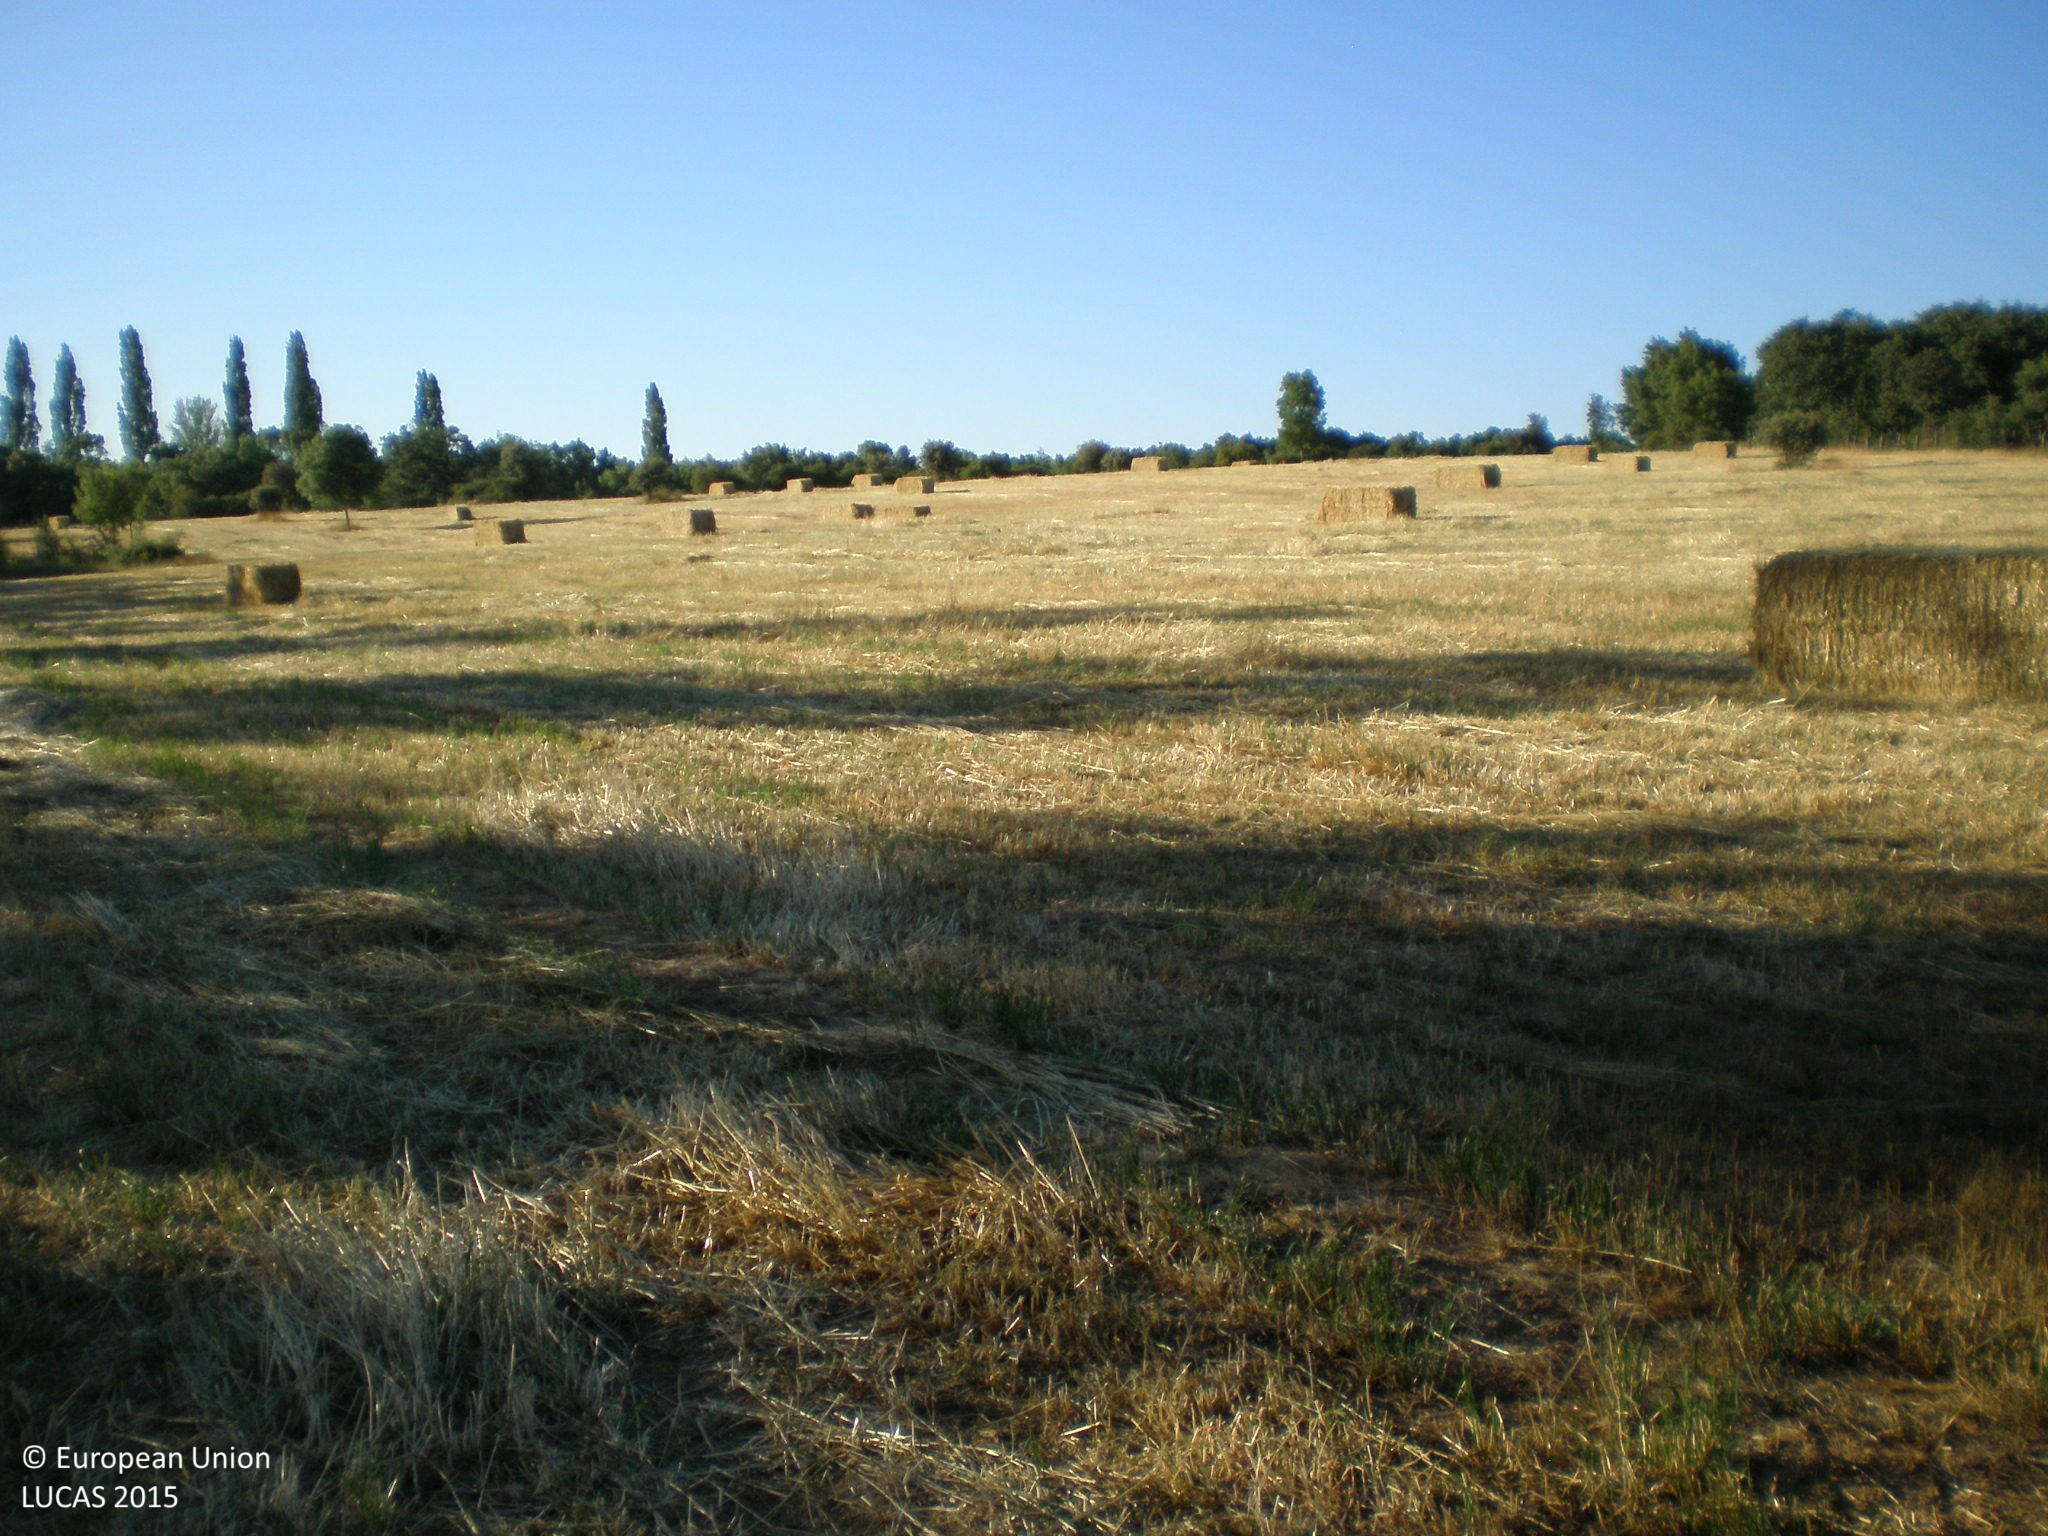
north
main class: Cropland
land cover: Mixed cereals for fodder
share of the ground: < 10 %
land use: Agriculture (excluding fallow land and kitchen gardens)
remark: Harvested field
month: June
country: ES
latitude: 40.5744
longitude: -5.8211
